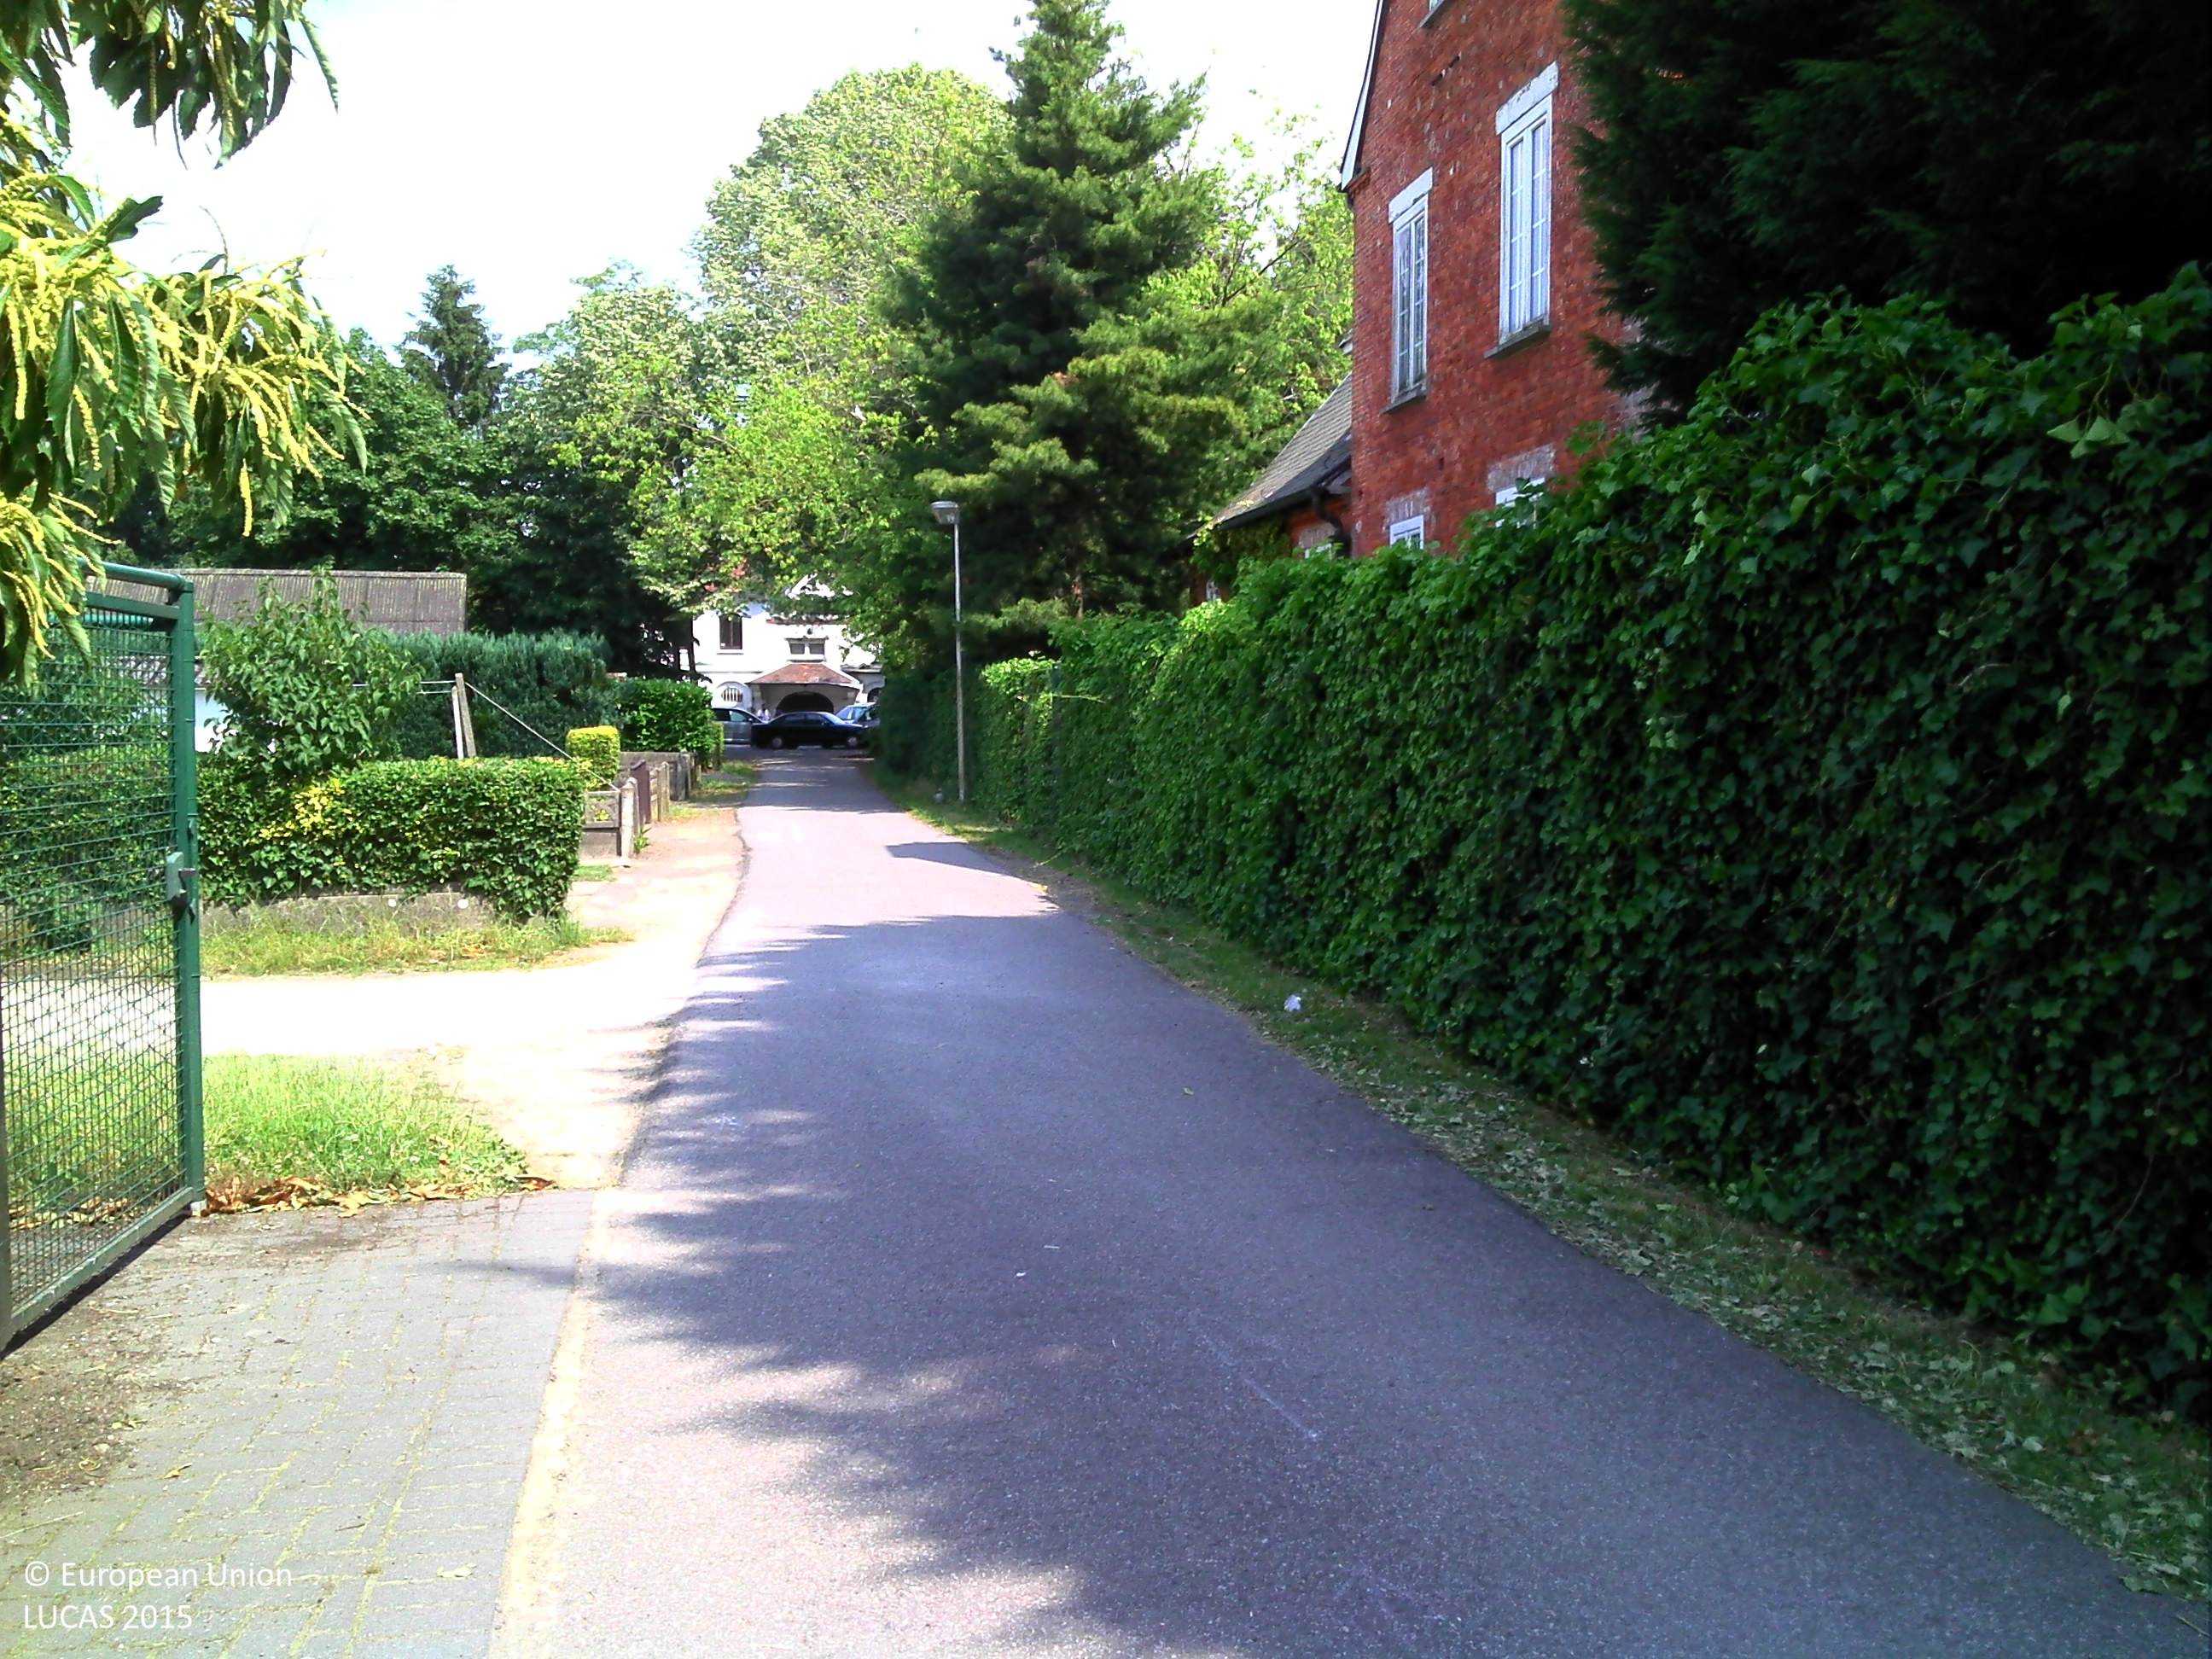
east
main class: Grassland
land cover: Grassland with sparse tree/shrub cover
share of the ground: > 75 %
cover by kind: herbaceous plants 95 %, broadleaved forest trees 5 %
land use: Residential
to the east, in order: Grassland with sparse tree/shrub cover; Artificial constructions in urban areas
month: July
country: BE
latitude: 50.9772
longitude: 5.4832
